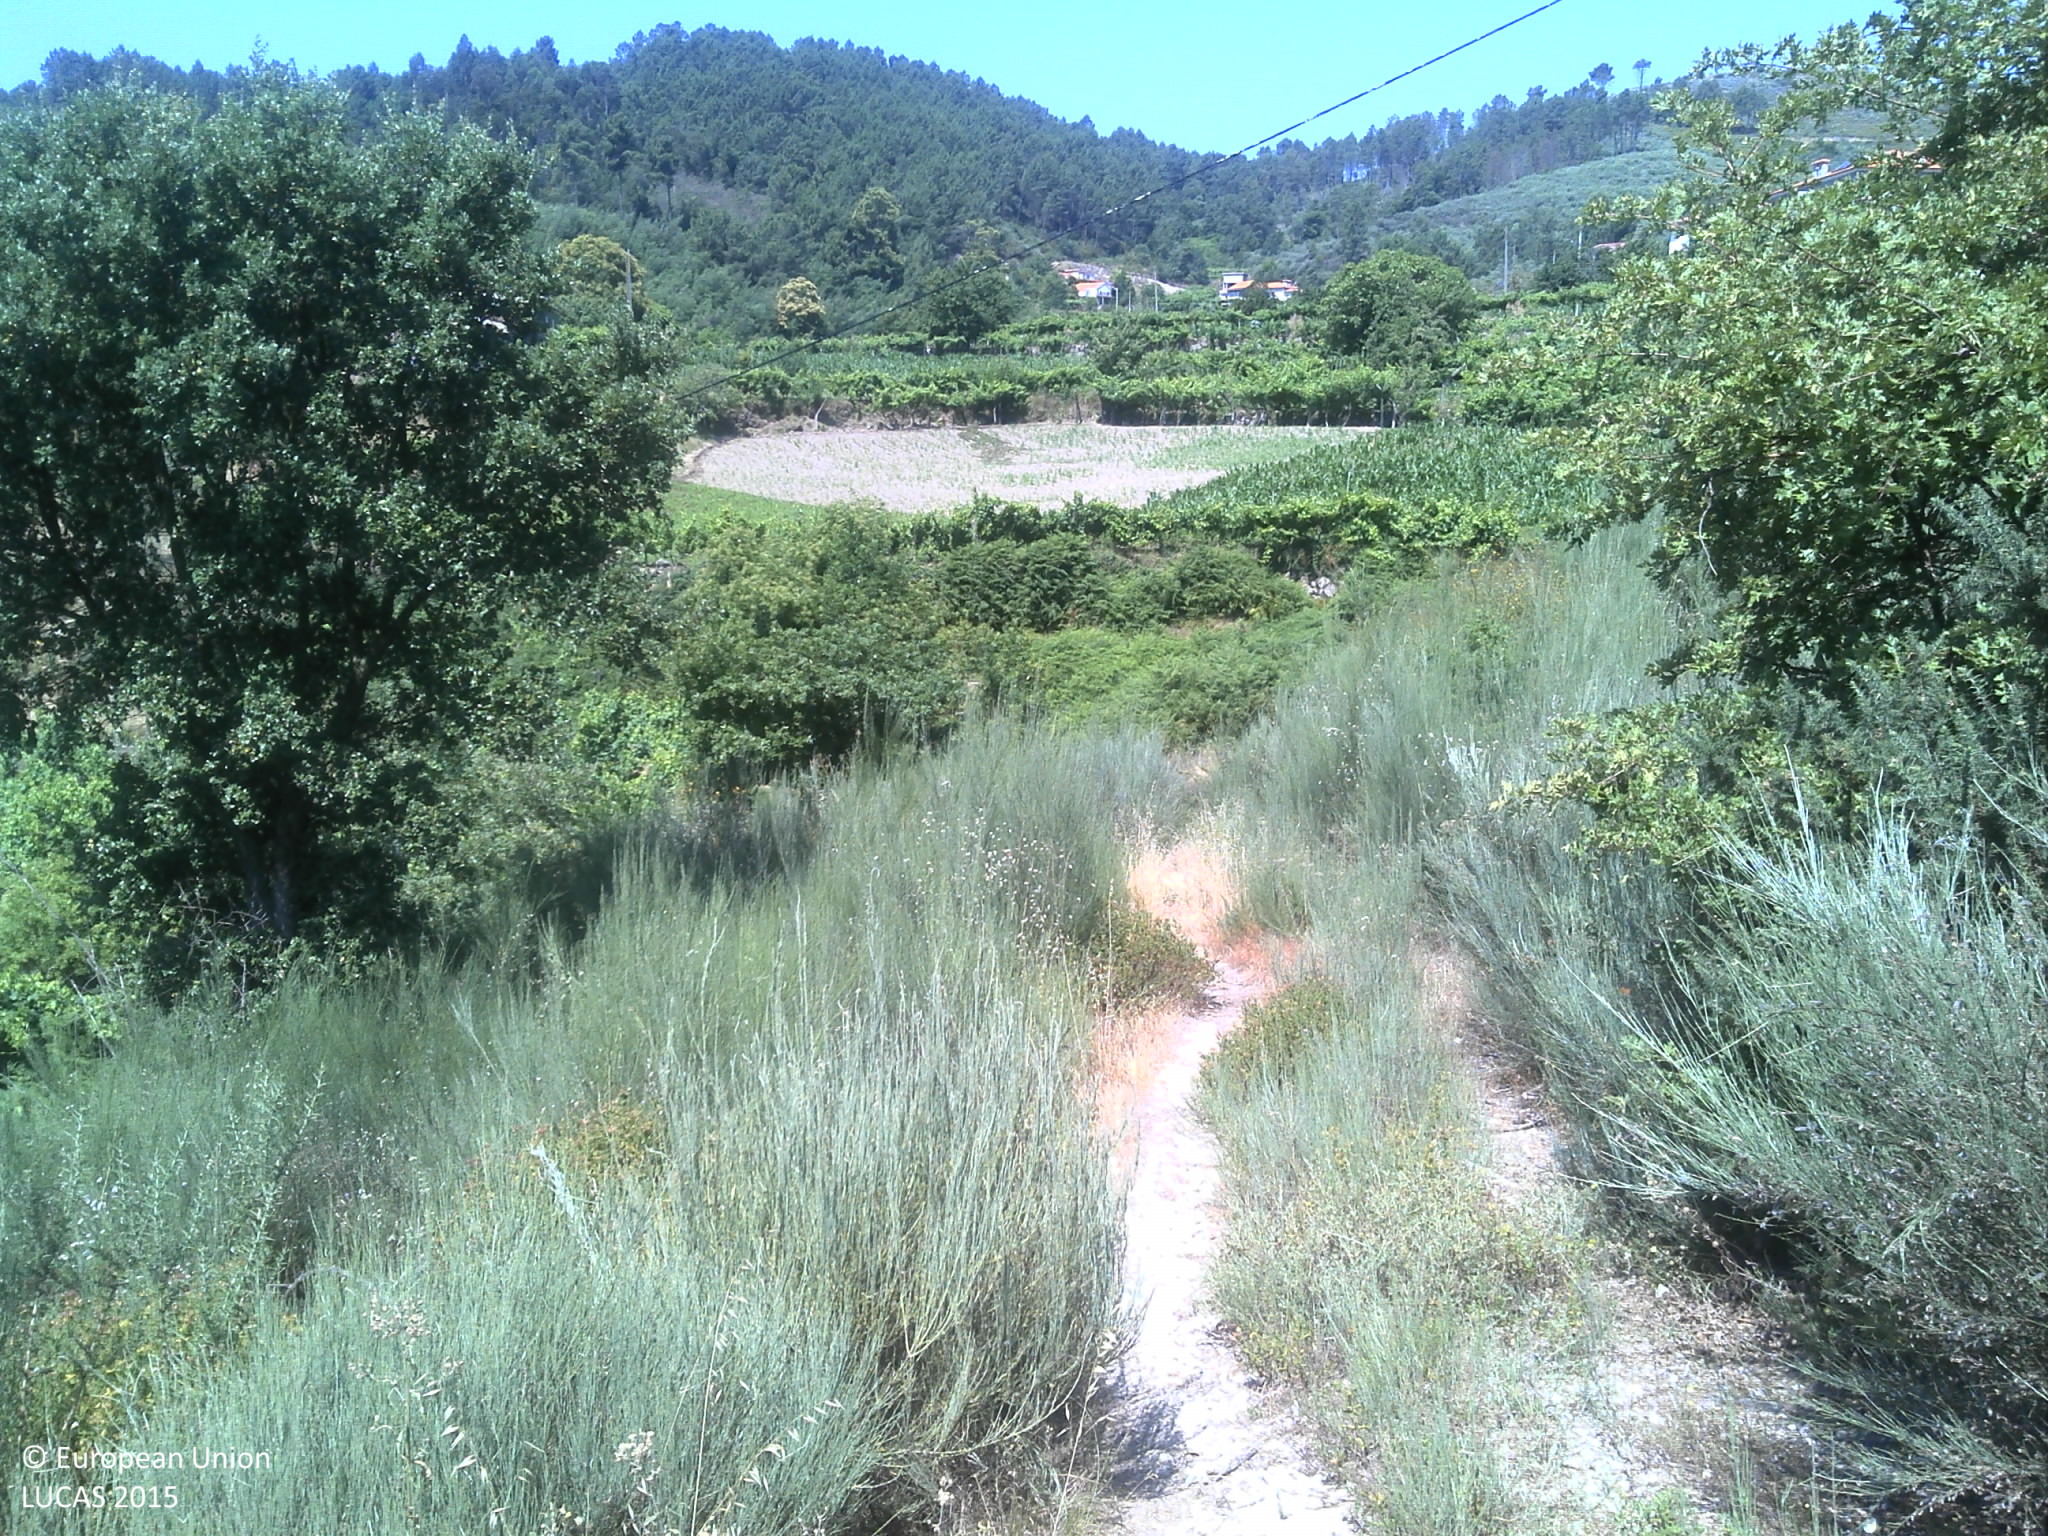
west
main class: Shrubland
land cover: Shrubland without tree cover
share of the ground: > 75 %
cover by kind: shrubs 85 %, herbaceous plants 10 %, unconsolidated bare surface 5 %
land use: Forestry
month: June
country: PT
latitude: 41.1420
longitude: -7.9695
